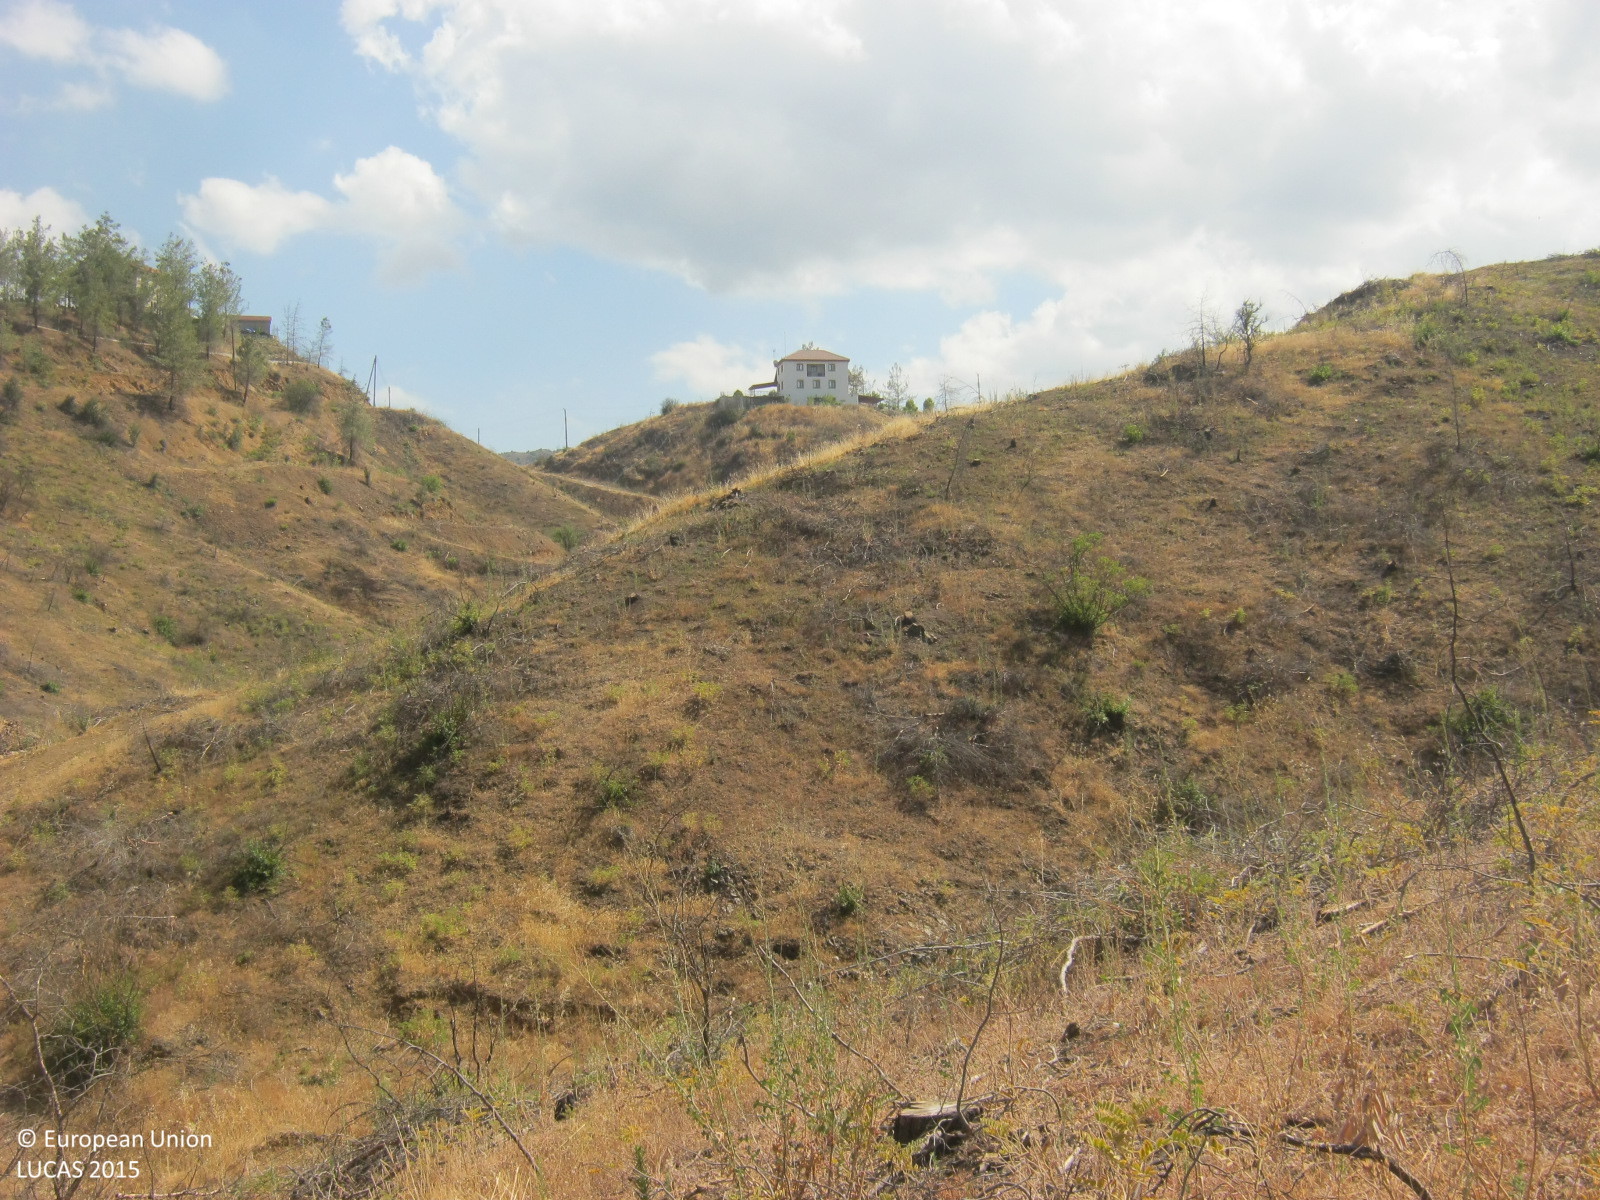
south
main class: Grassland
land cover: Grassland without tree/shrub cover
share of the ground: 10 - 25 %
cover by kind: unconsolidated bare surface 80 %, herbaceous plants 15 %, shrubs 5 %
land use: Forestry
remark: Burnt area
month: June
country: CY
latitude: 34.9806
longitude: 33.1500
